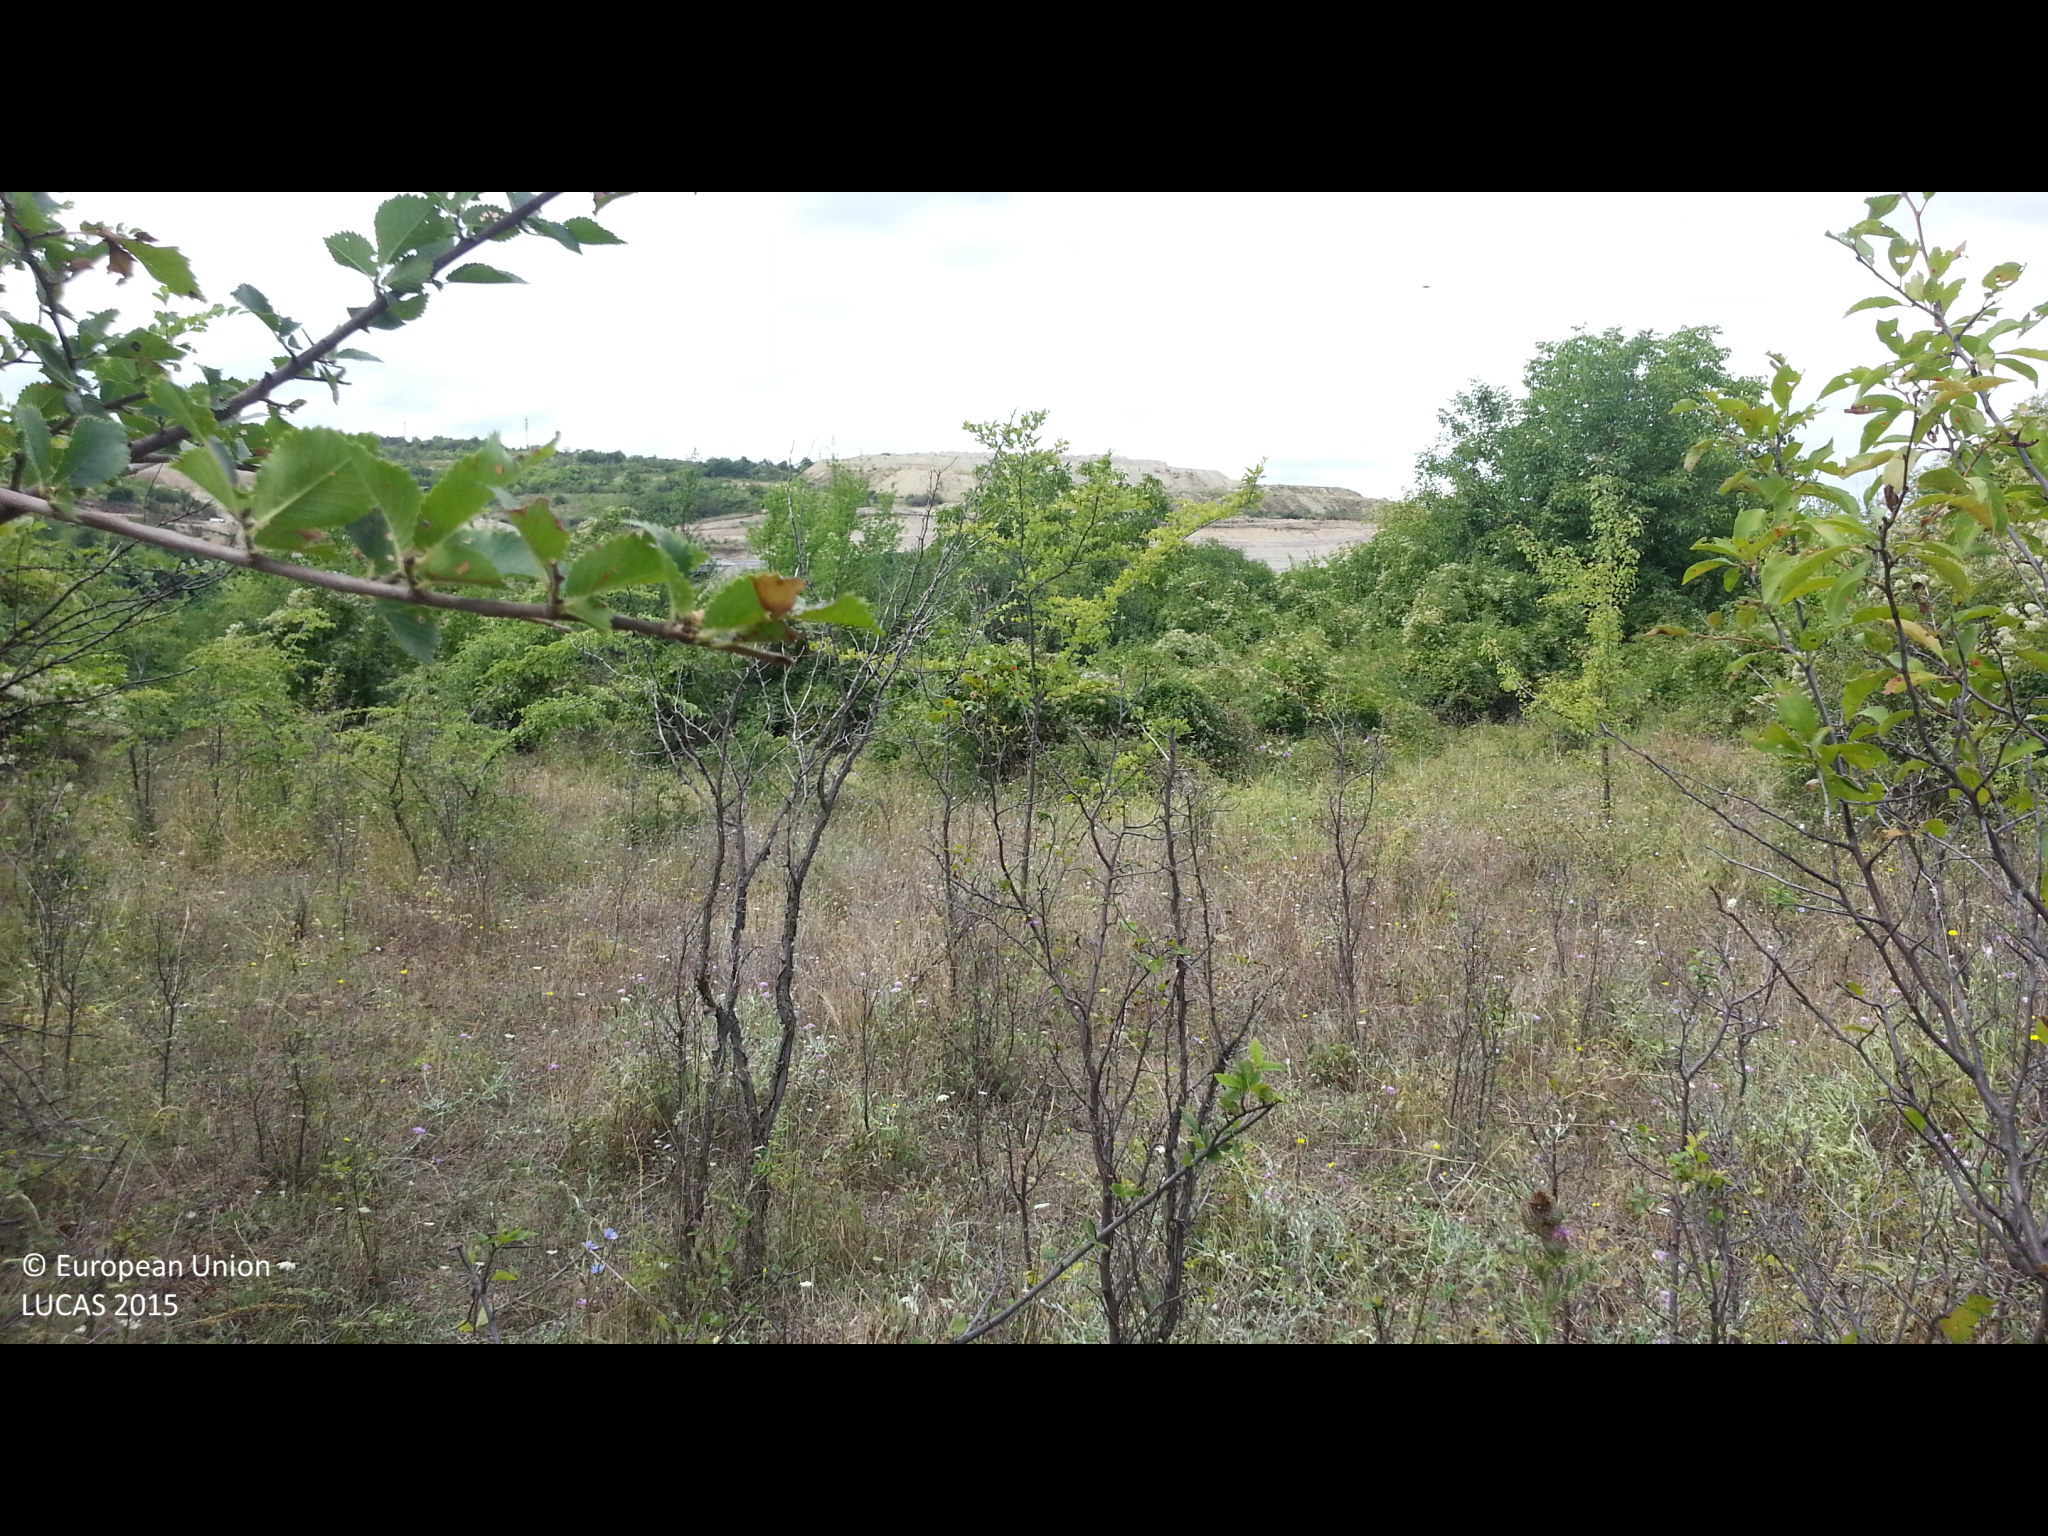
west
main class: Shrubland
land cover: Shrubland with sparse tree cover
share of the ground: > 75 %
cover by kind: herbaceous plants 60 %, shrubs 35 %, broadleaved forest trees 5 %
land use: Abandoned areas
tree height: < 5 m
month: August
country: BG
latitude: 42.2583
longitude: 23.0819
